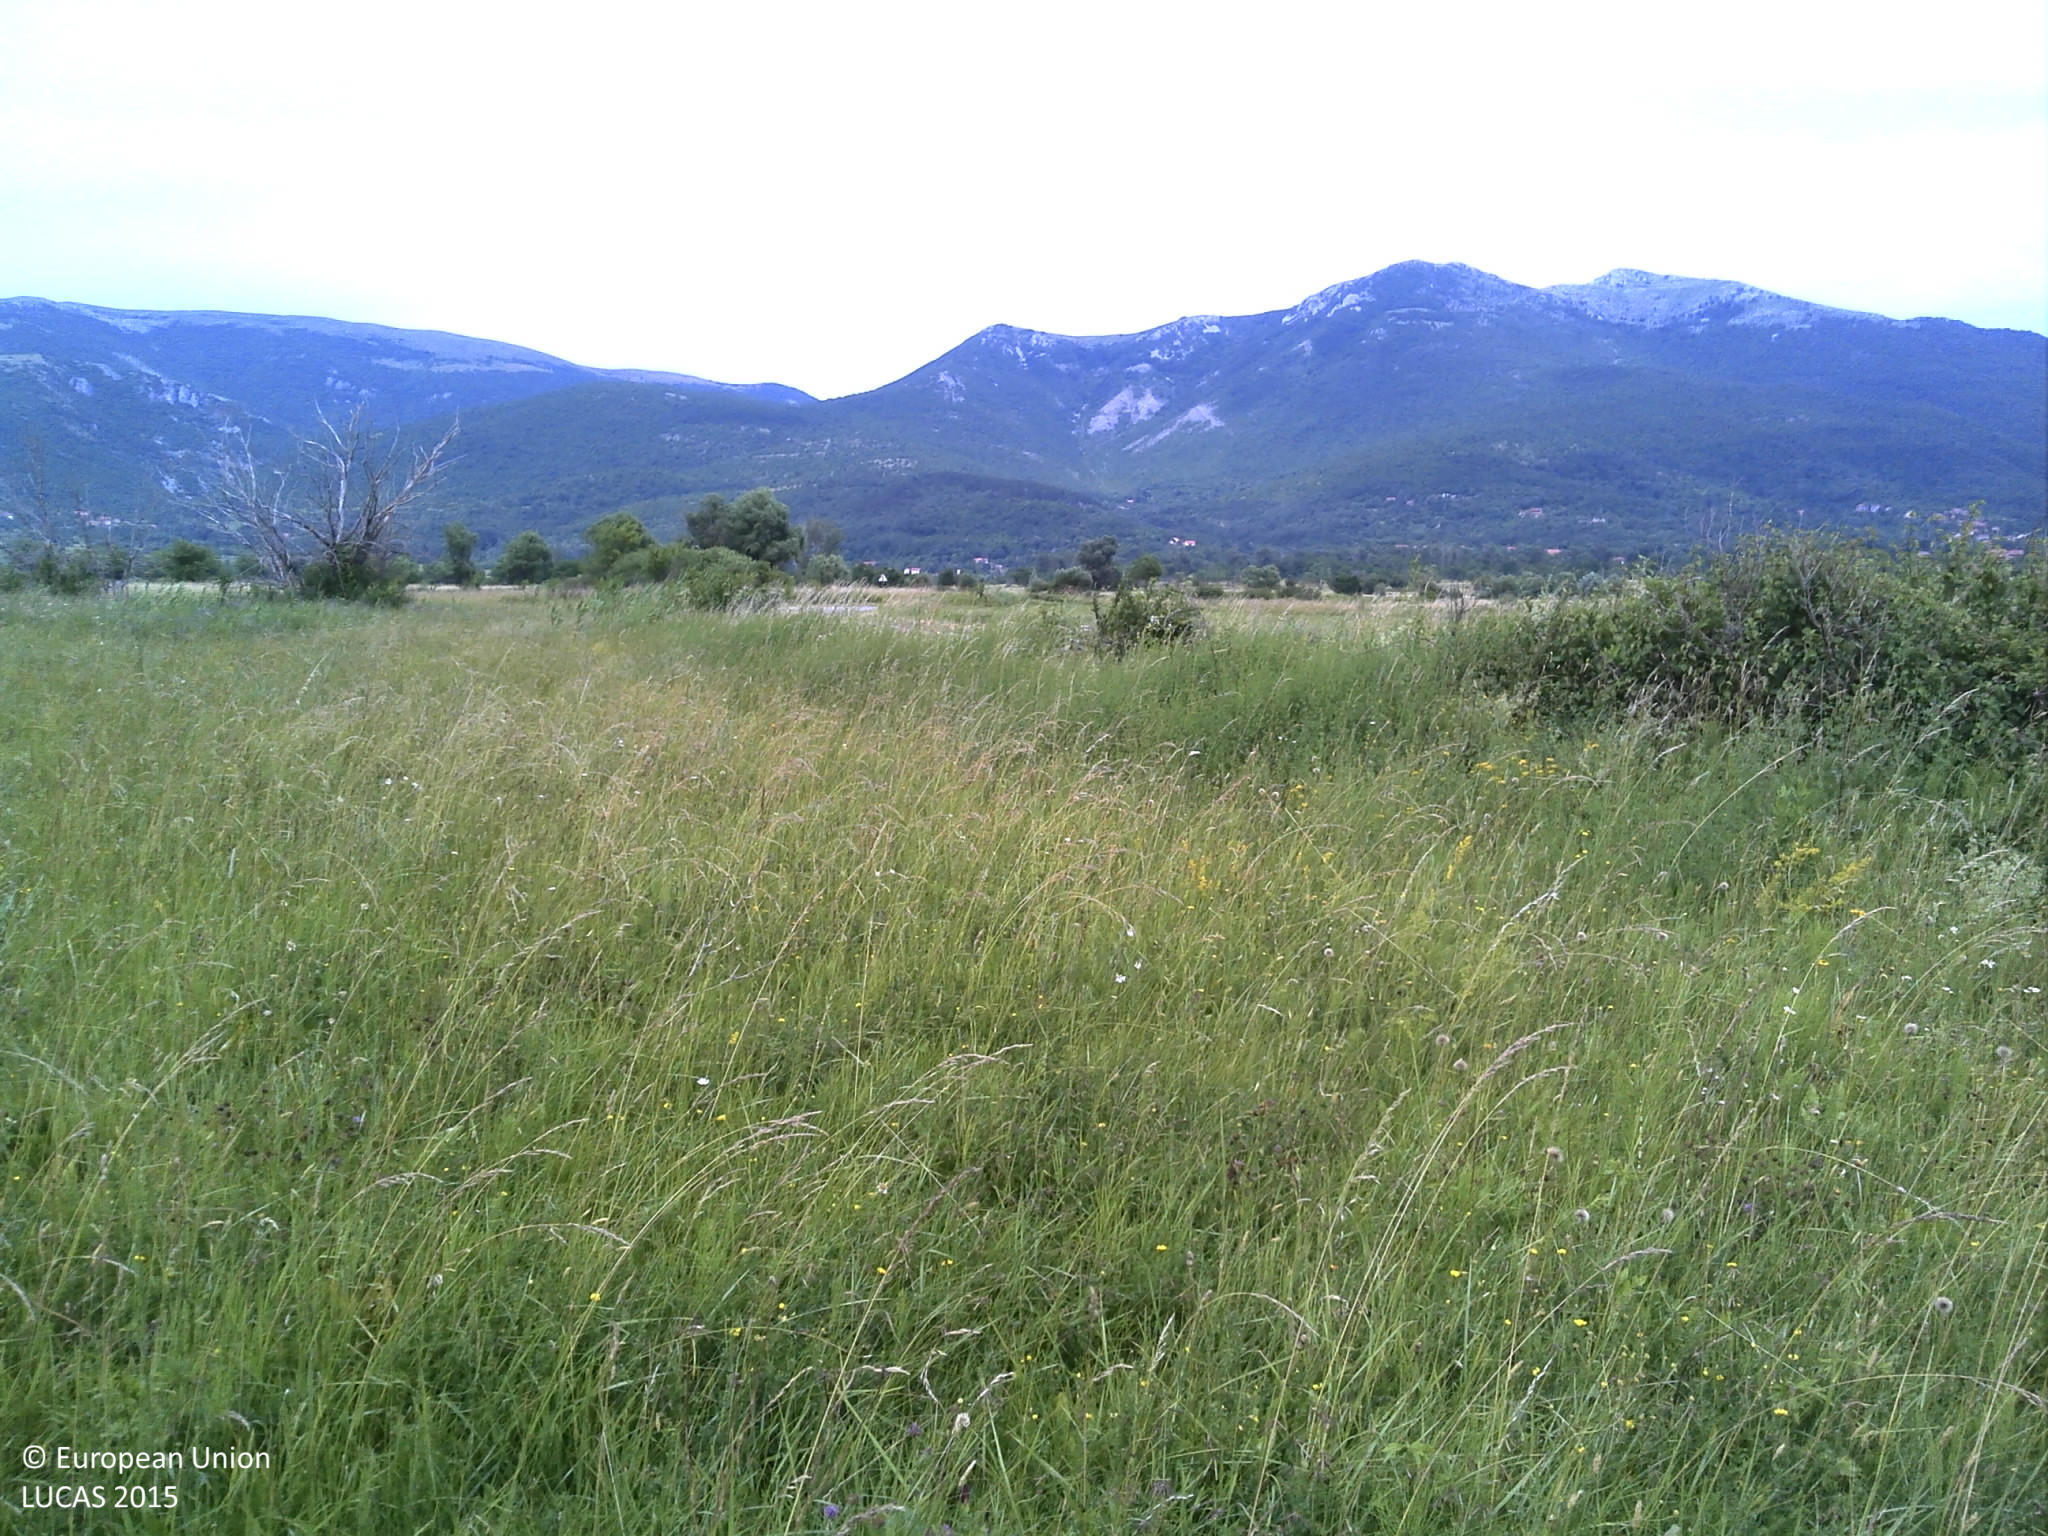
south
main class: Grassland
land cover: Spontaneously vegetated surfaces
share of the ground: > 75 %
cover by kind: herbaceous plants 95 %, shrubs 5 %
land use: Fallow land
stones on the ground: < 10 %
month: June
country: HR
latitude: 44.1496
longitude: 16.1565
